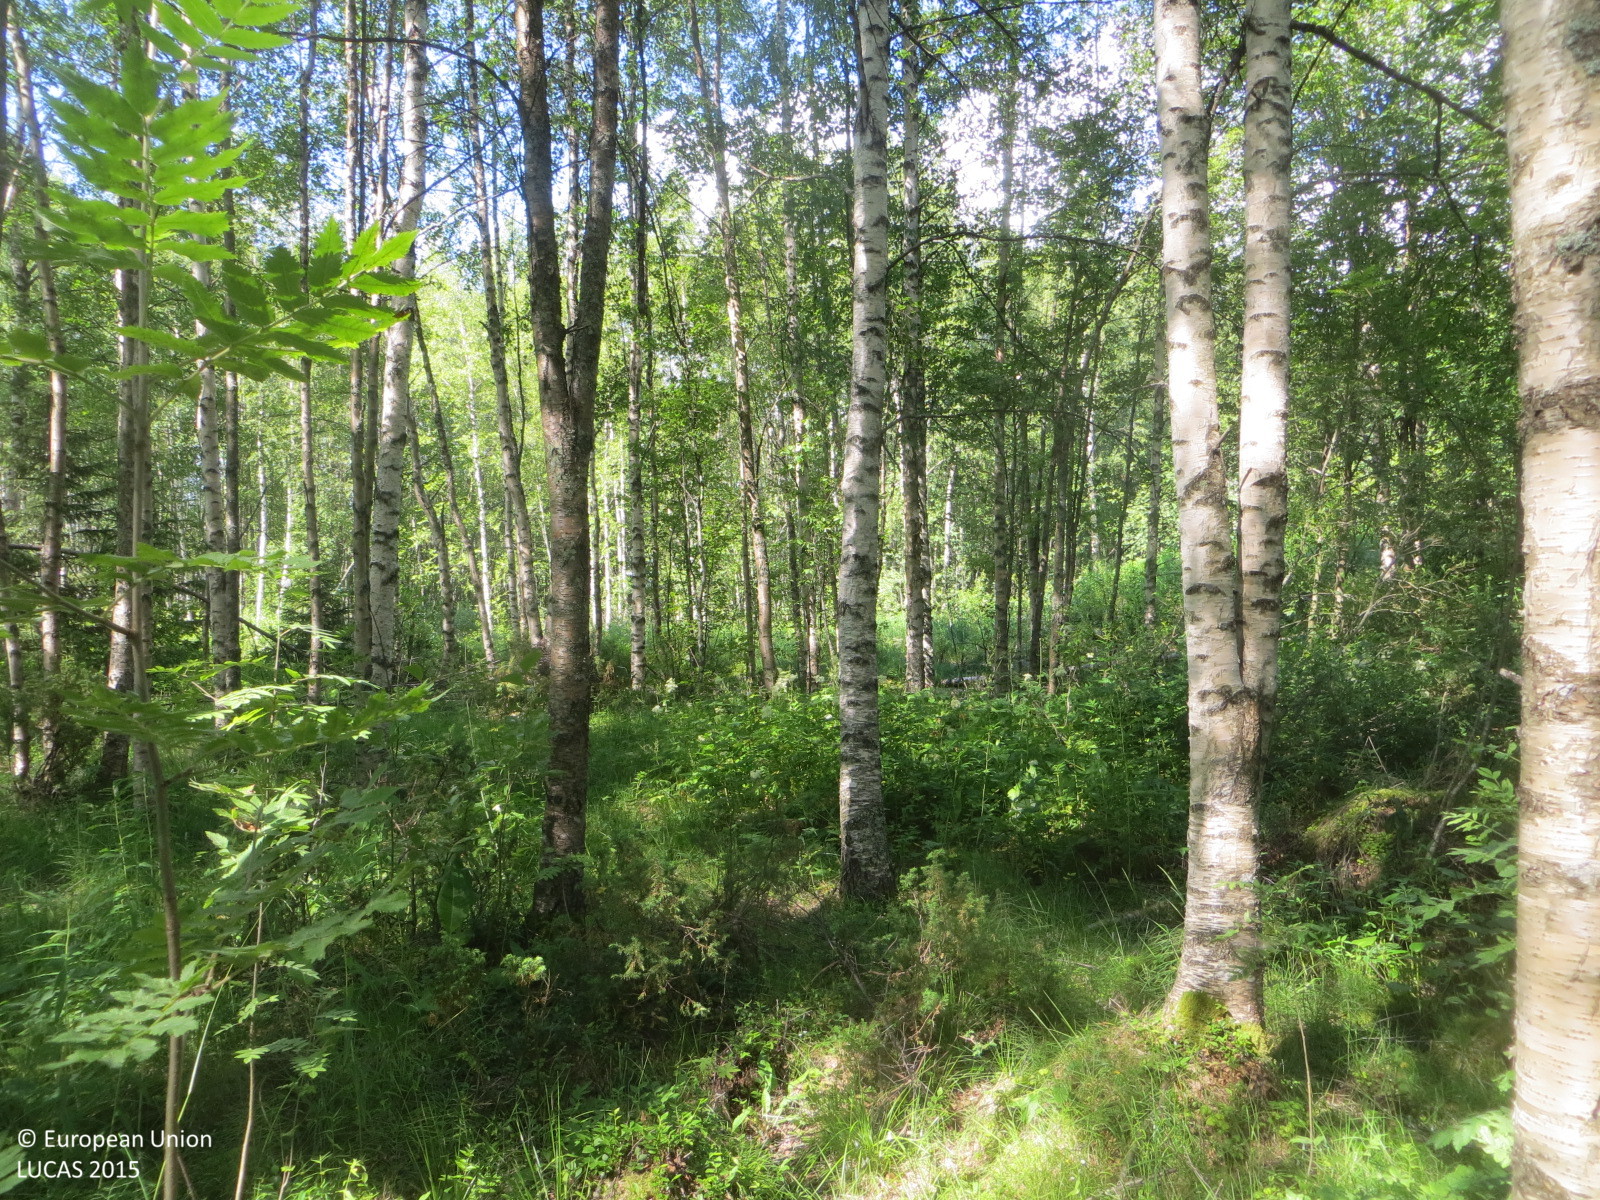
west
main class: Woodland
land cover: Broadleaved woodland
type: boreal forest
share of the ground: > 75 %
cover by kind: broadleaved forest trees 85 %, herbaceous plants 10 %, shrubs 5 %
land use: Forestry
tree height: > 5 m
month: July
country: FI
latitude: 65.8369
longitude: 24.2134
